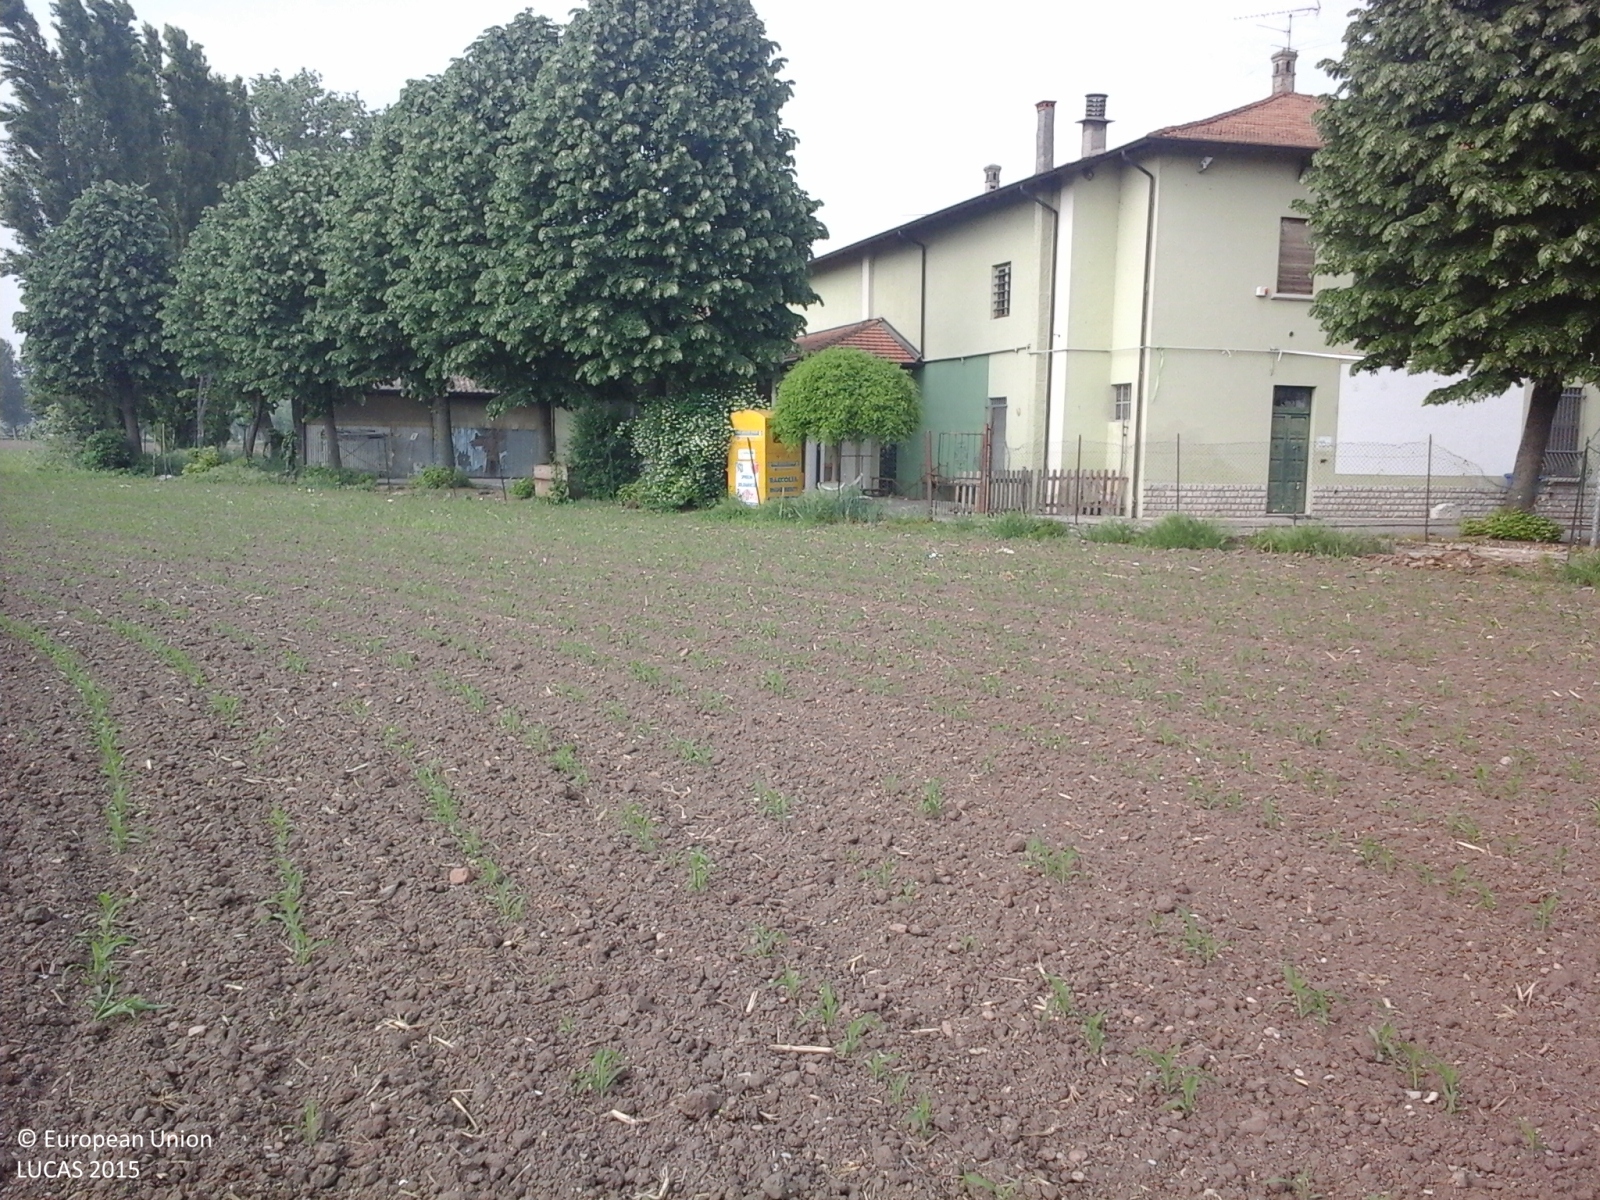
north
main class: Cropland
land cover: Maize
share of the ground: > 75 %
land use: Agriculture (excluding fallow land and kitchen gardens)
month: May
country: IT
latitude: 45.2336
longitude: 10.3178
